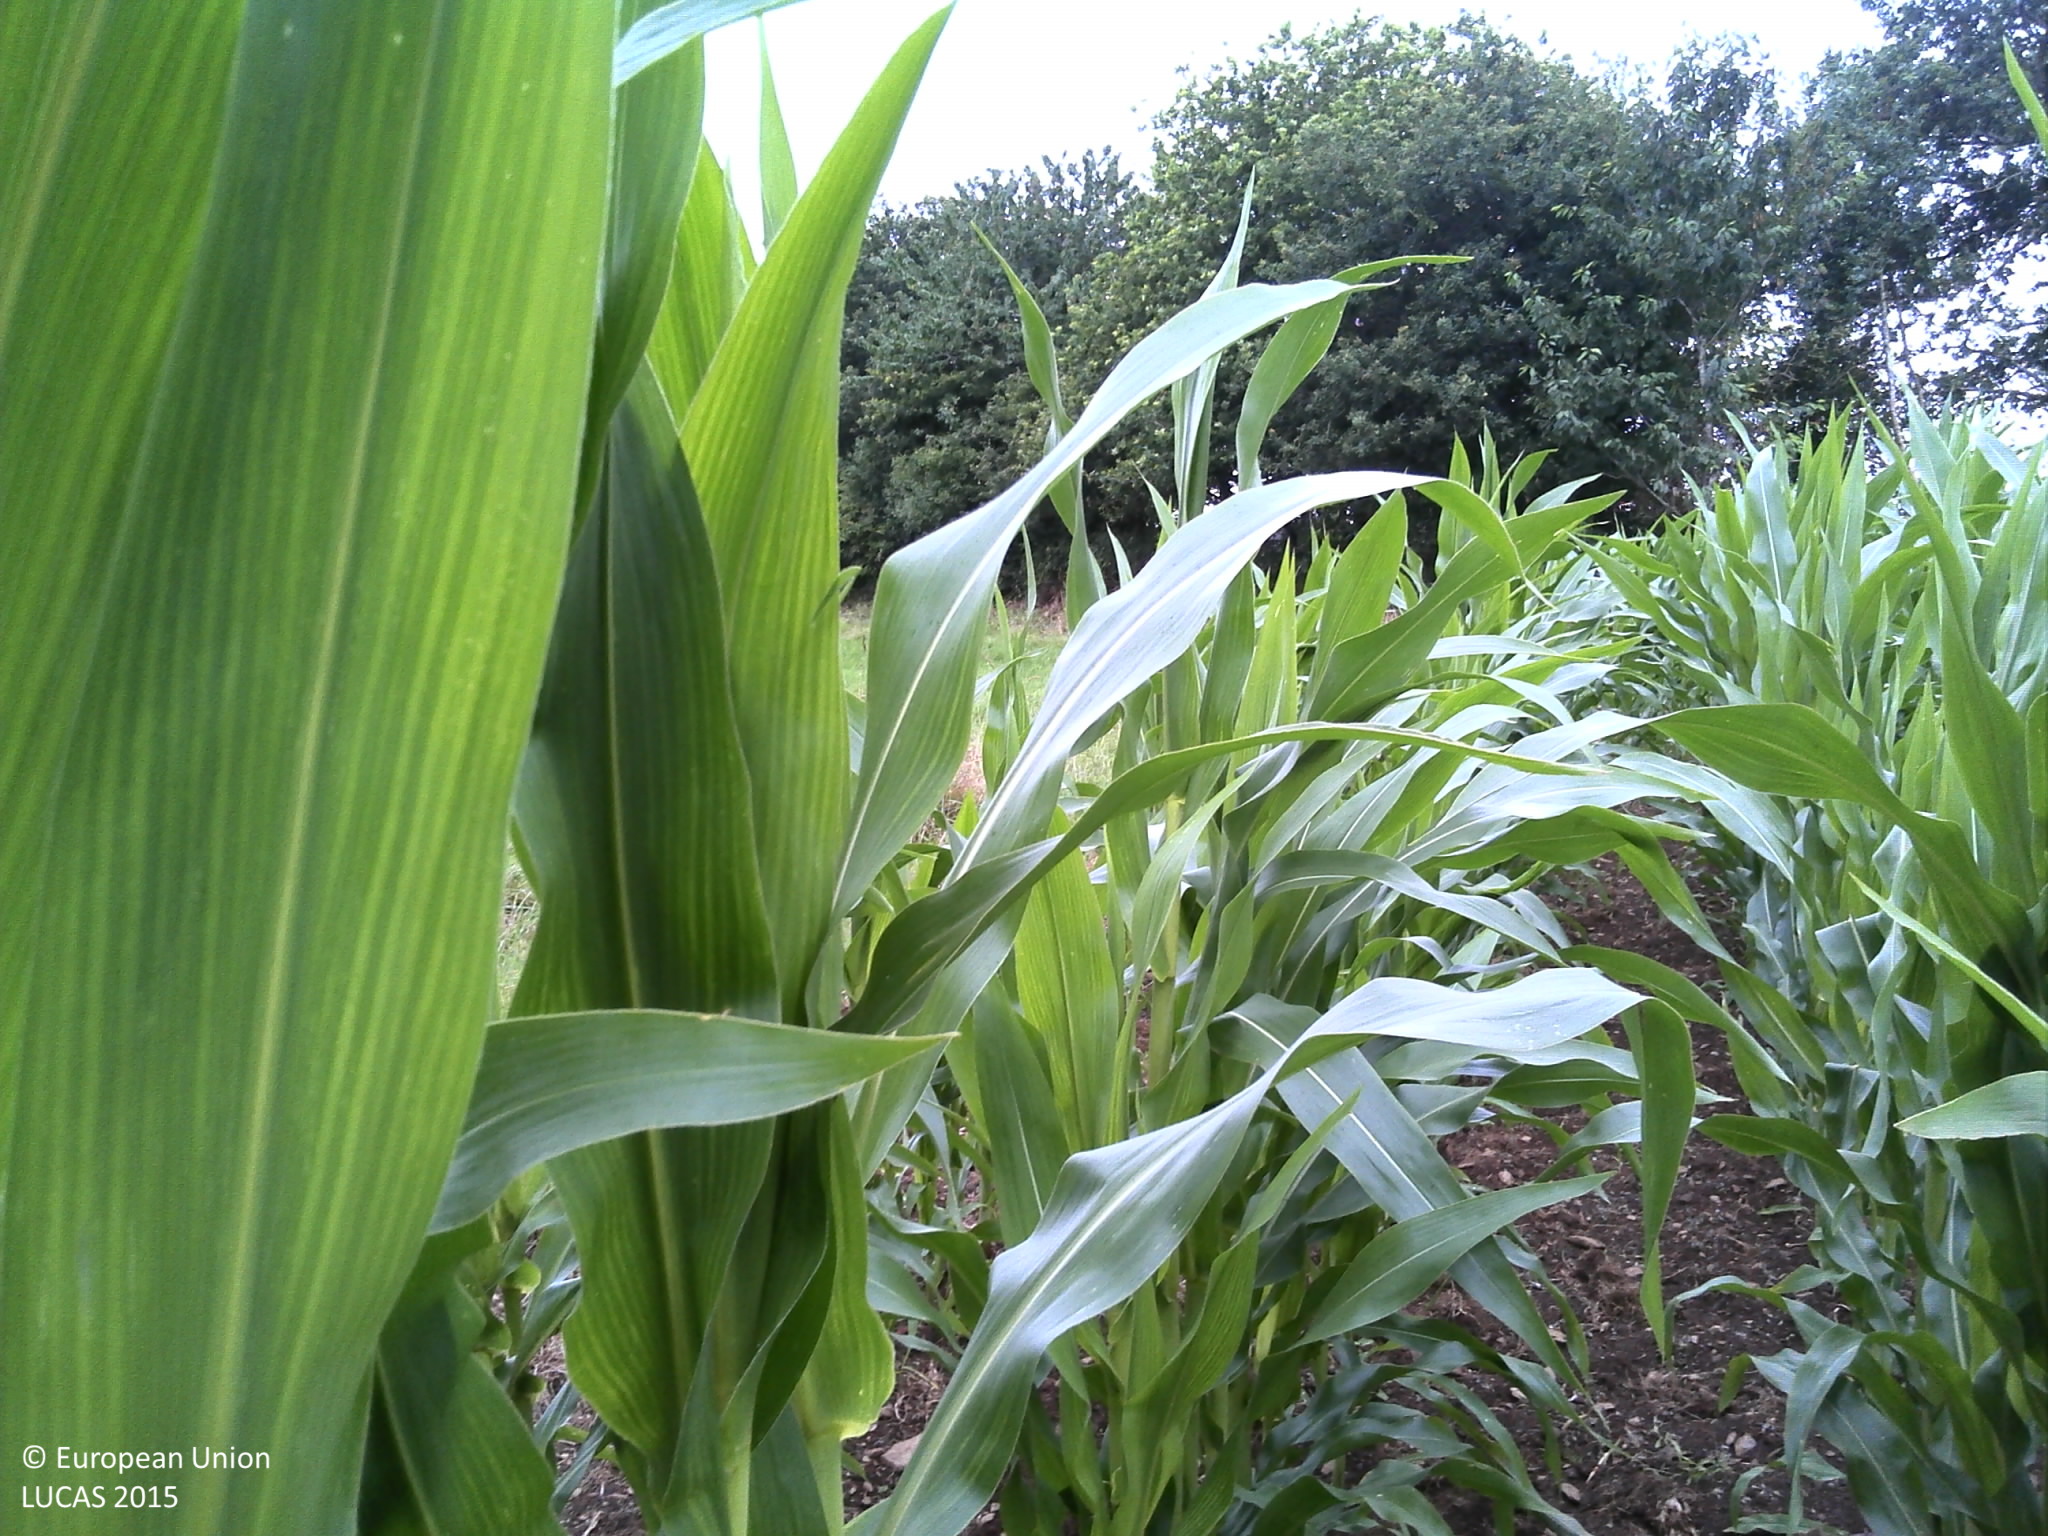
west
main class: Cropland
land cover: Maize
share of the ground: > 75 %
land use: Agriculture (excluding fallow land and kitchen gardens)
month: July
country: FR
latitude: 48.3233
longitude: -4.1855
